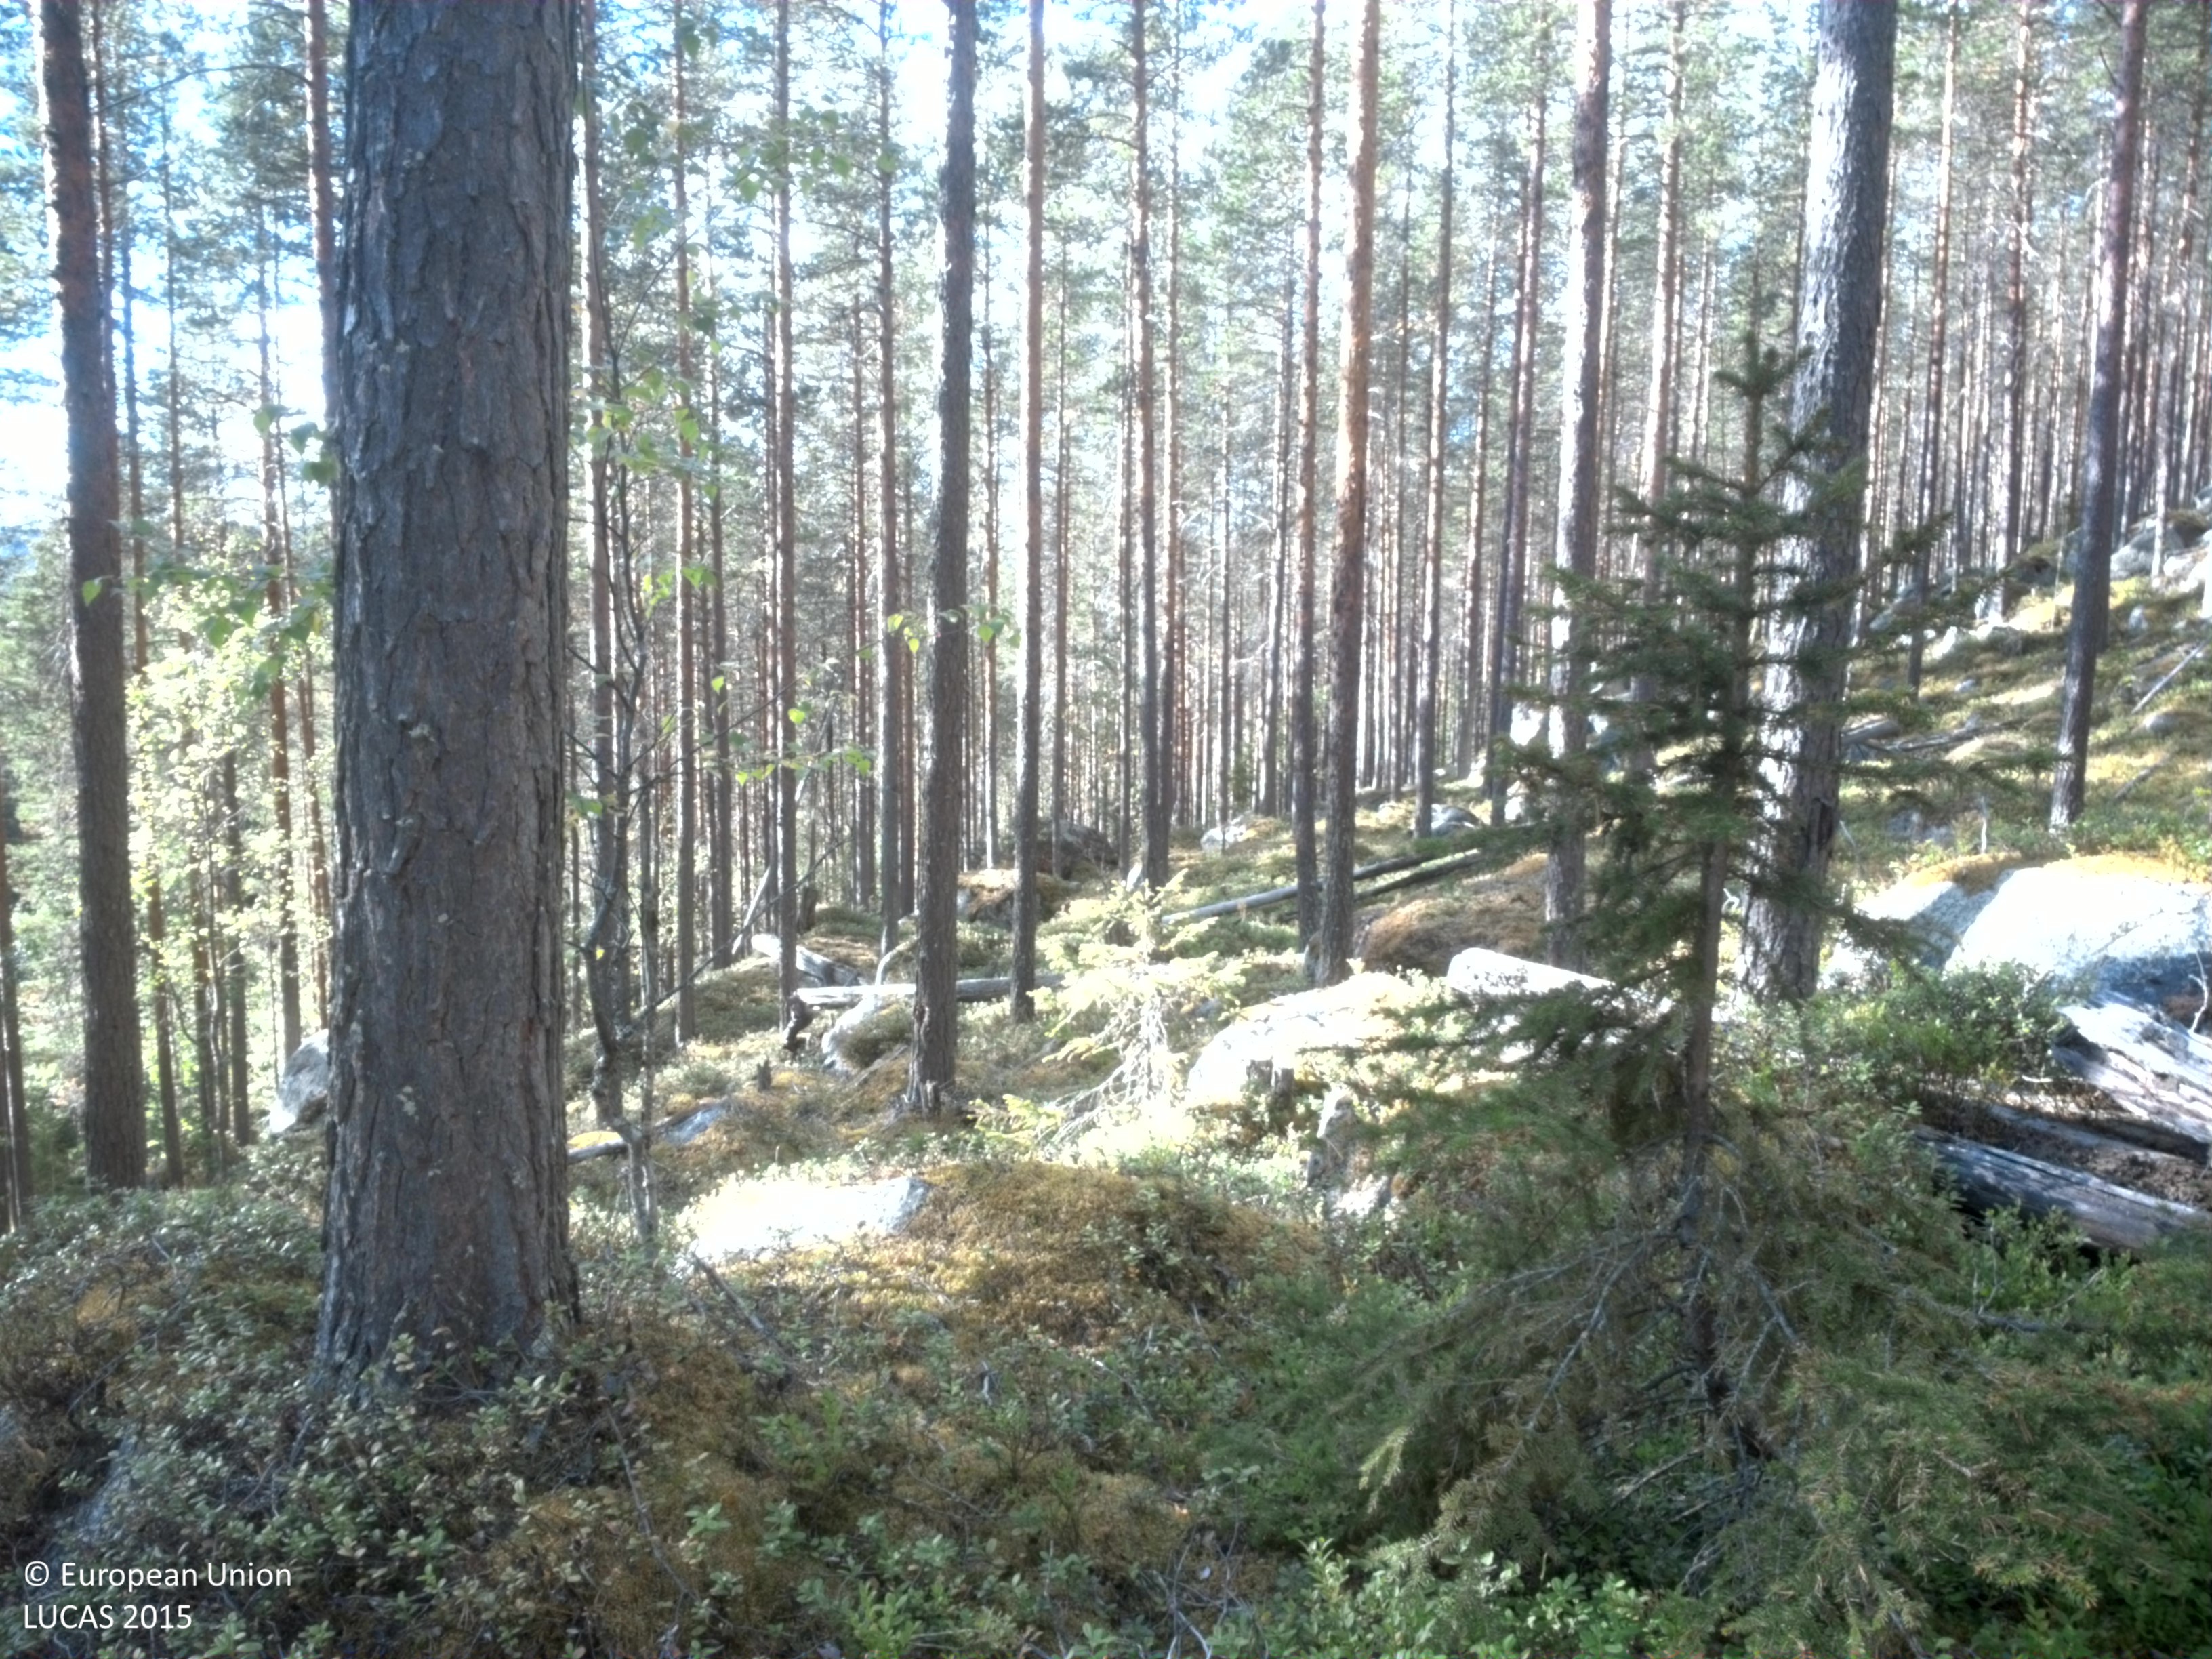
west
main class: Woodland
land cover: Pine dominated coniferous woodland
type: boreal forest
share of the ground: 50 - 75 %
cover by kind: coniferous forest trees 55 %, shrubs 30 %, lichens and mosses 15 %
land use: Forestry
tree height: > 5 m
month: September
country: SE
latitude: 64.4107
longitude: 19.0803
